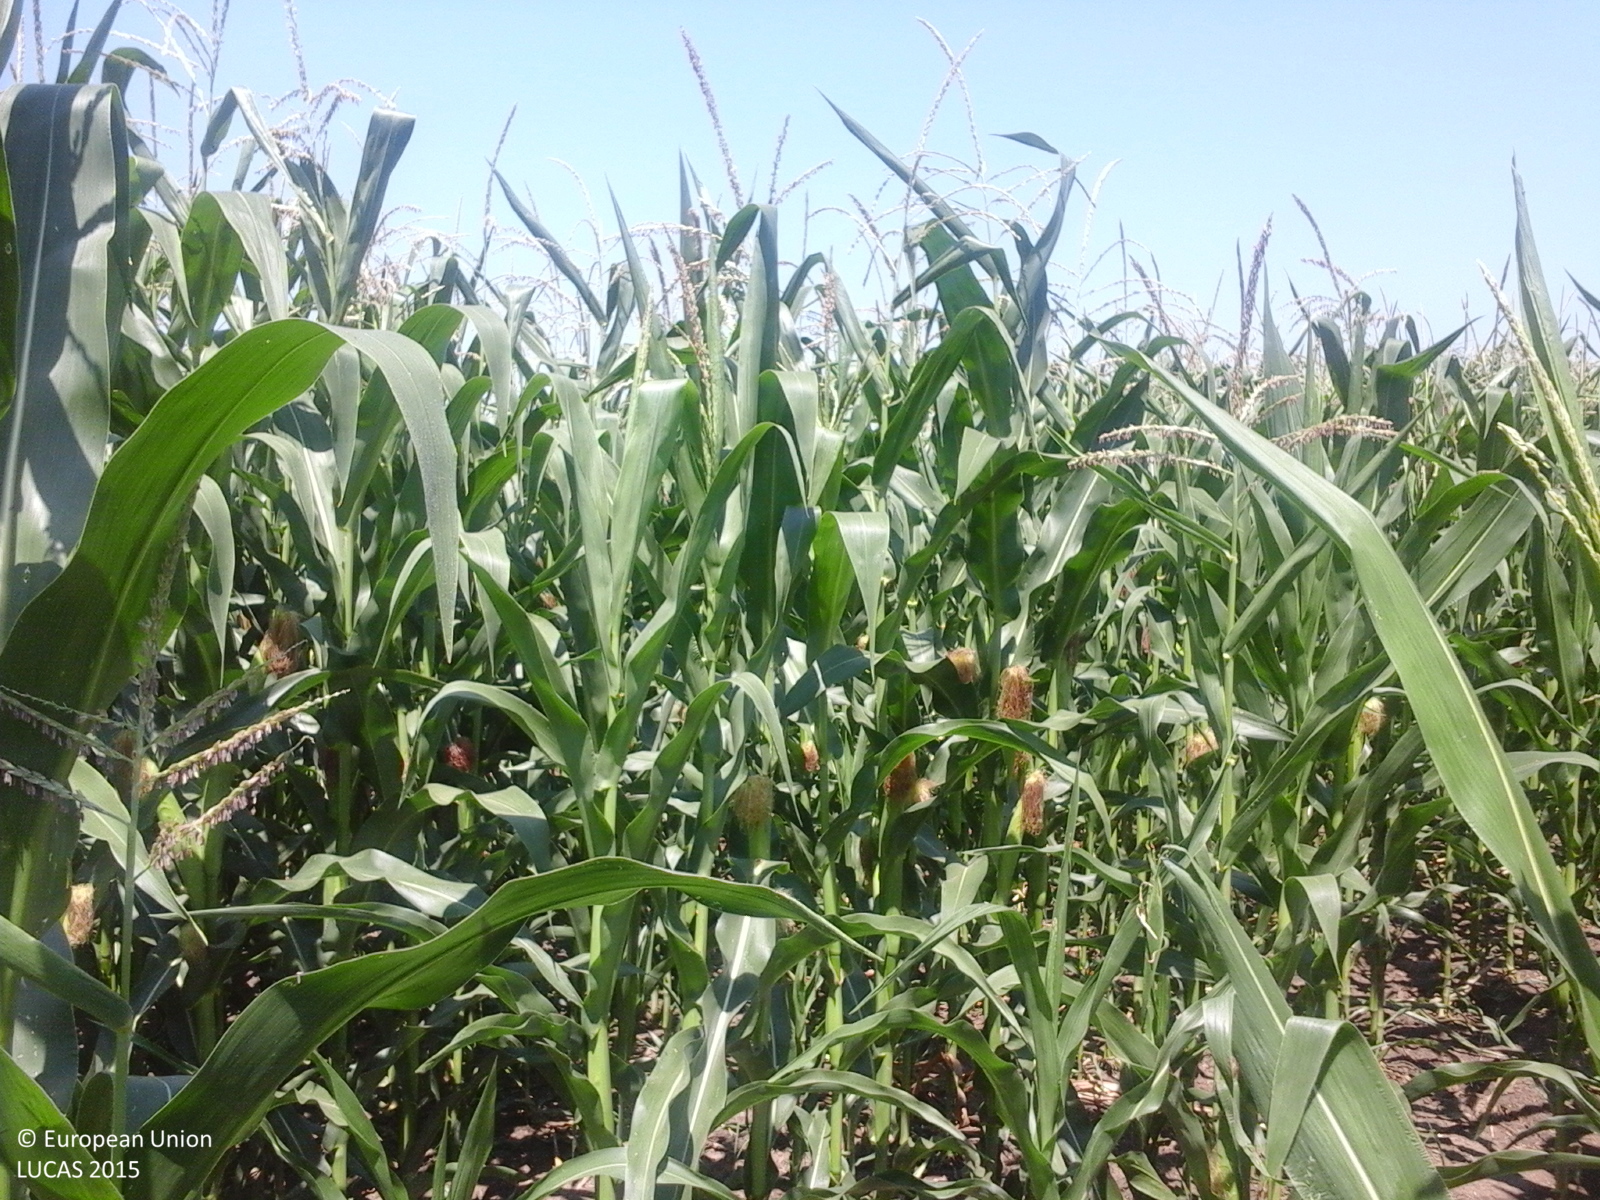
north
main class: Cropland
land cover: Maize
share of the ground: > 75 %
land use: Agriculture (excluding fallow land and kitchen gardens)
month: July
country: RO
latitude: 44.7198
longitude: 26.7769
